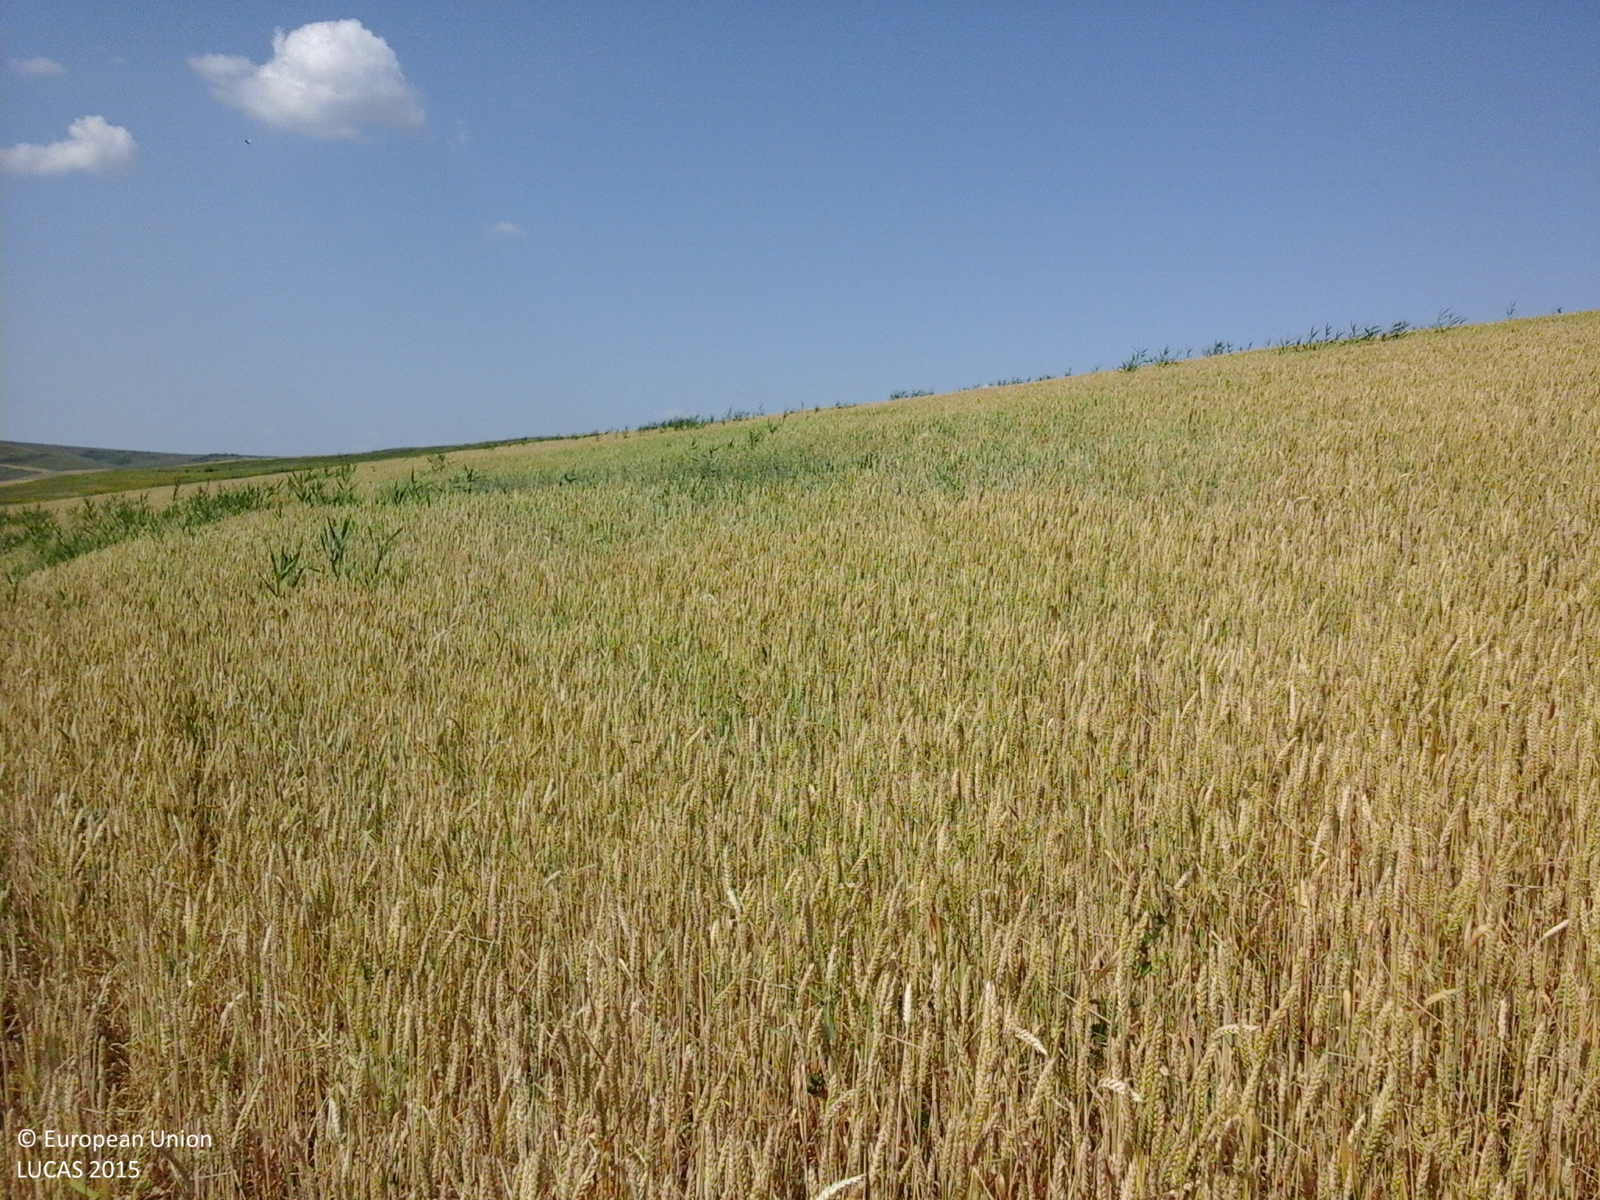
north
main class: Cropland
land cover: Common wheat
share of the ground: > 75 %
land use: Agriculture (excluding fallow land and kitchen gardens)
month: June
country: RO
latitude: 47.2431
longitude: 27.4341
